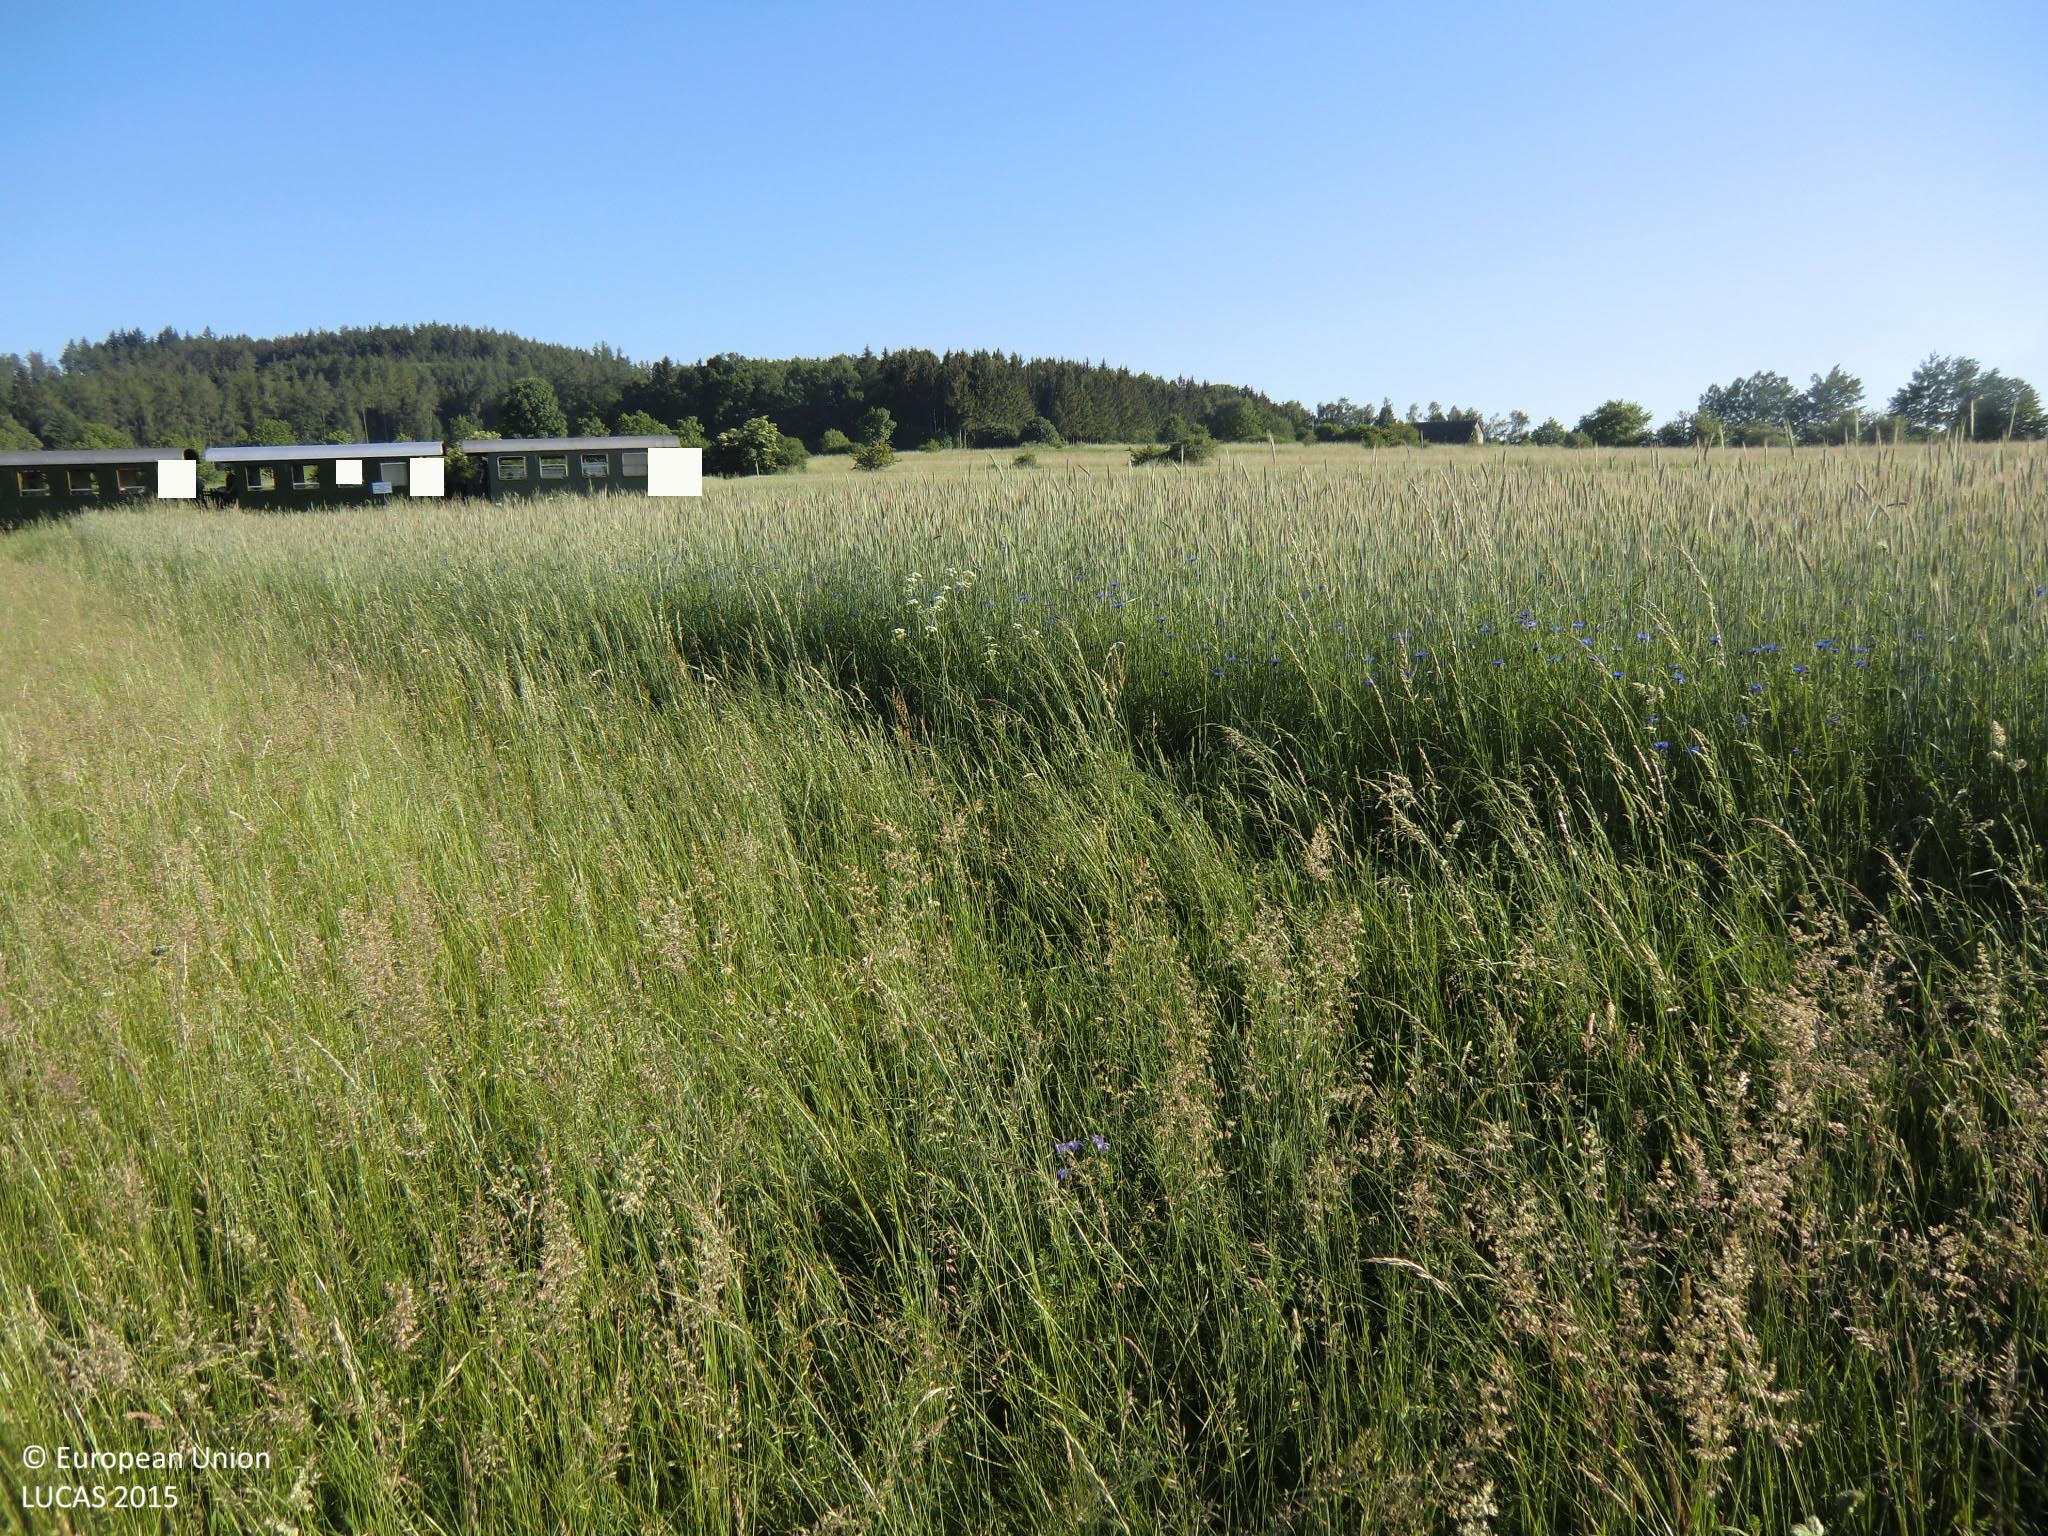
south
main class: Grassland
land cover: Grassland without tree/shrub cover
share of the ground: > 75 %
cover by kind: herbaceous plants 100 %
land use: Agriculture (excluding fallow land and kitchen gardens)
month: June
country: AT
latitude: 48.6924
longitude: 14.8787
